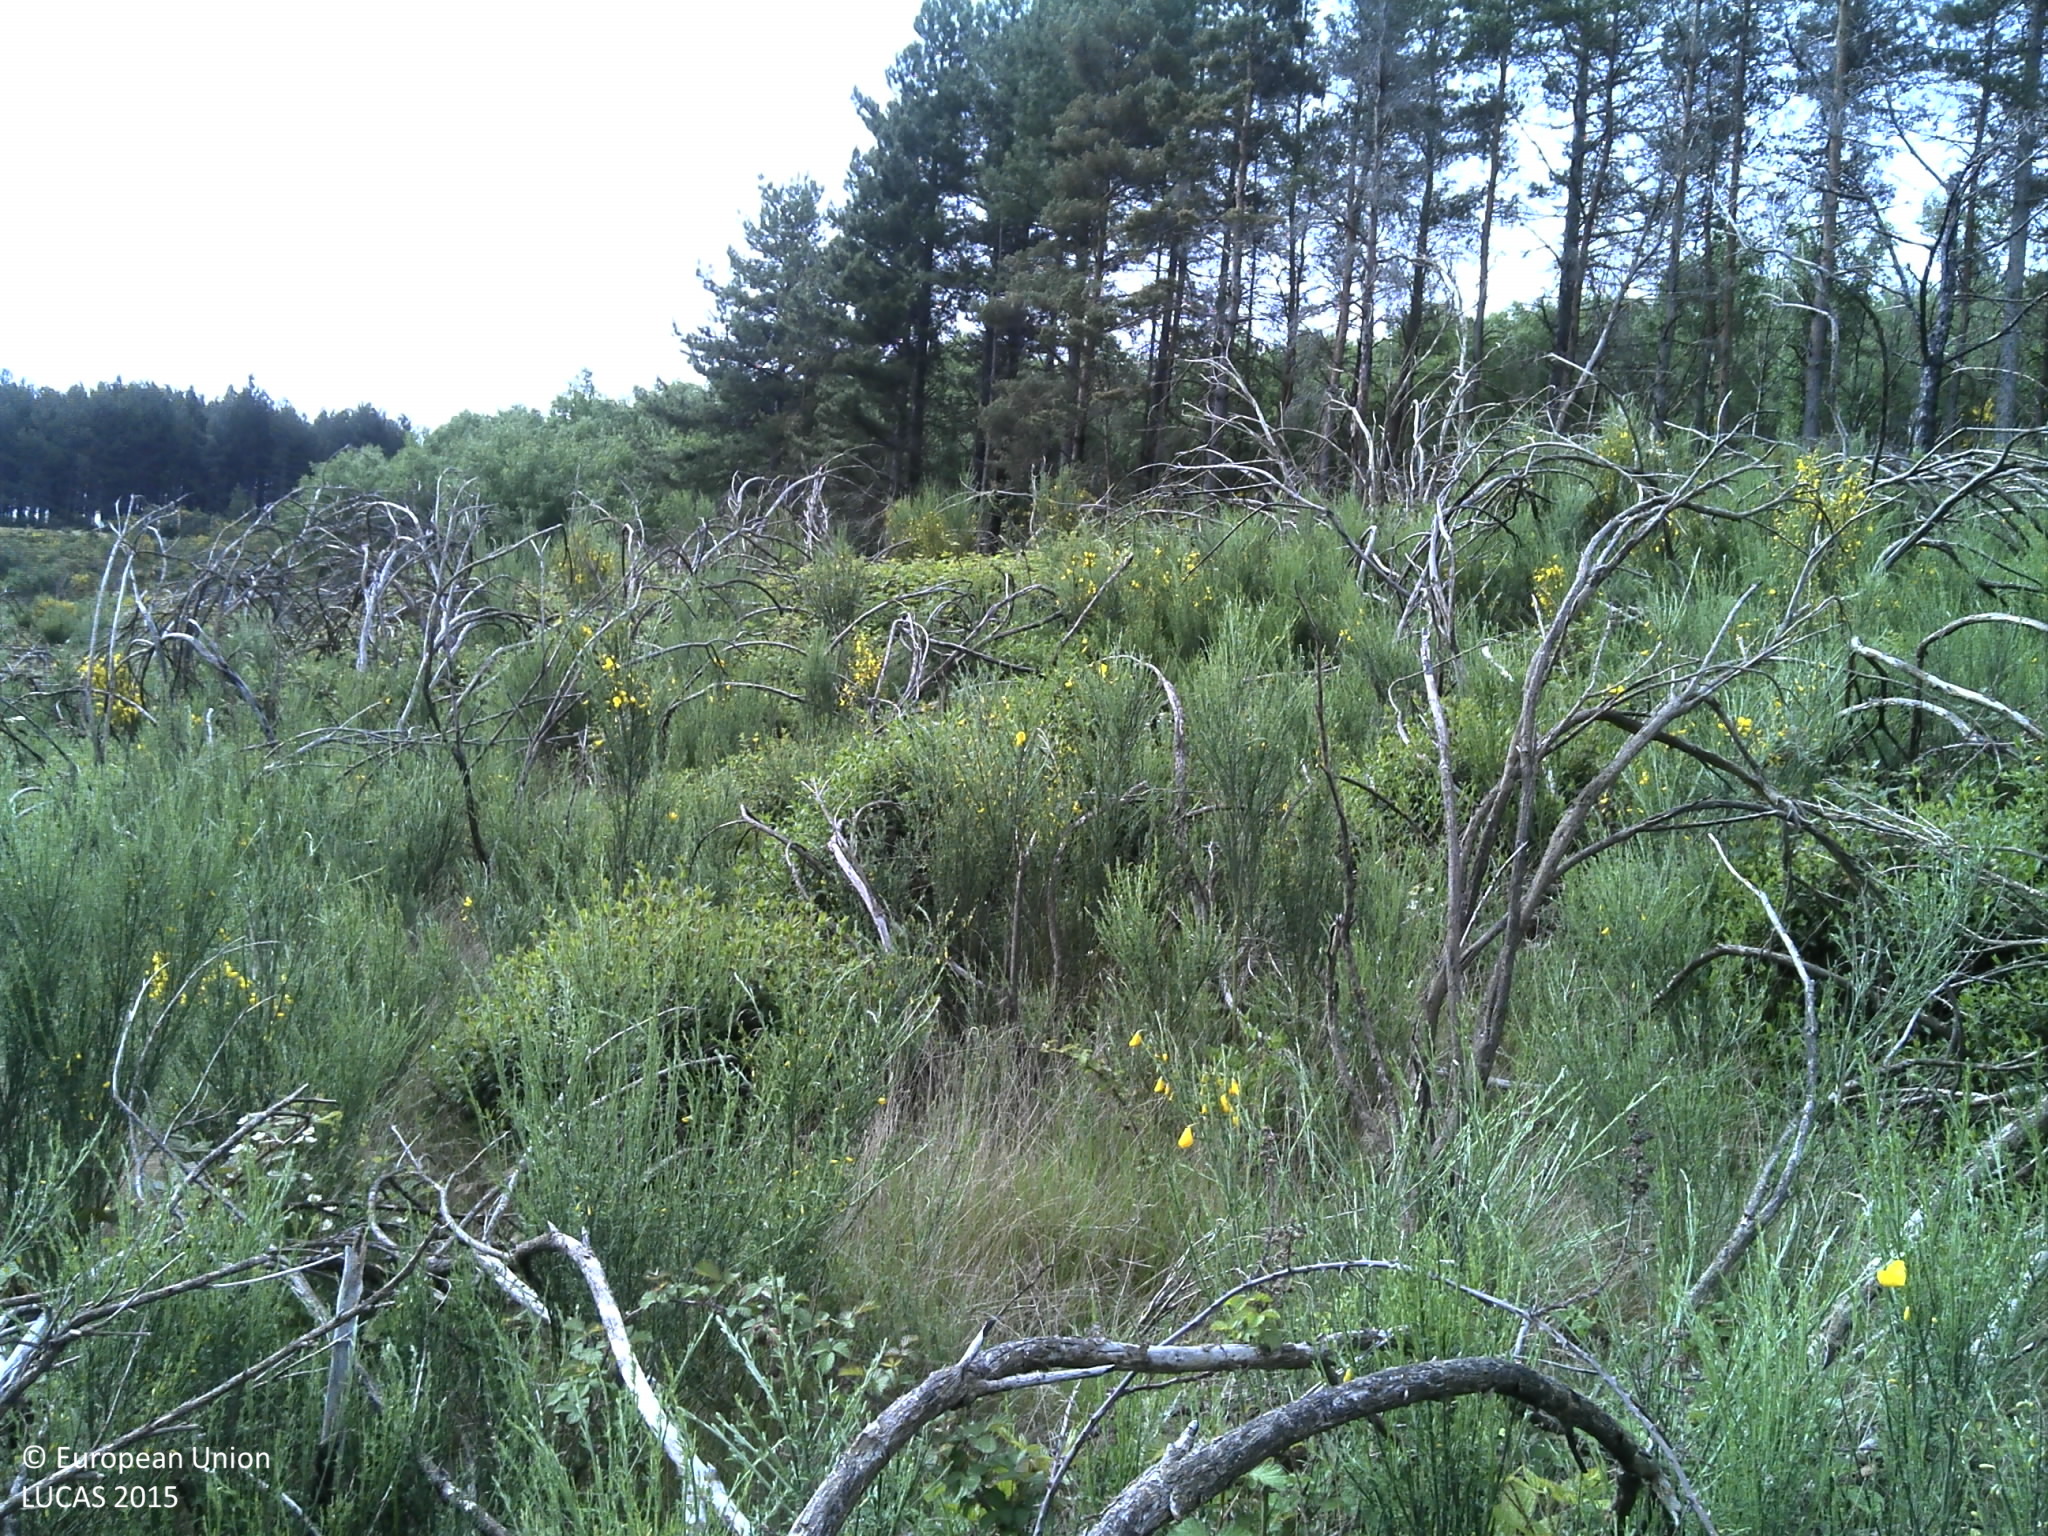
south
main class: Shrubland
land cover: Shrubland without tree cover
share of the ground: > 75 %
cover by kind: shrubs 75 %, herbaceous plants 15 %, unconsolidated bare surface 10 %
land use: Abandoned areas
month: May
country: PT
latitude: 41.6745
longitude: -6.9443
